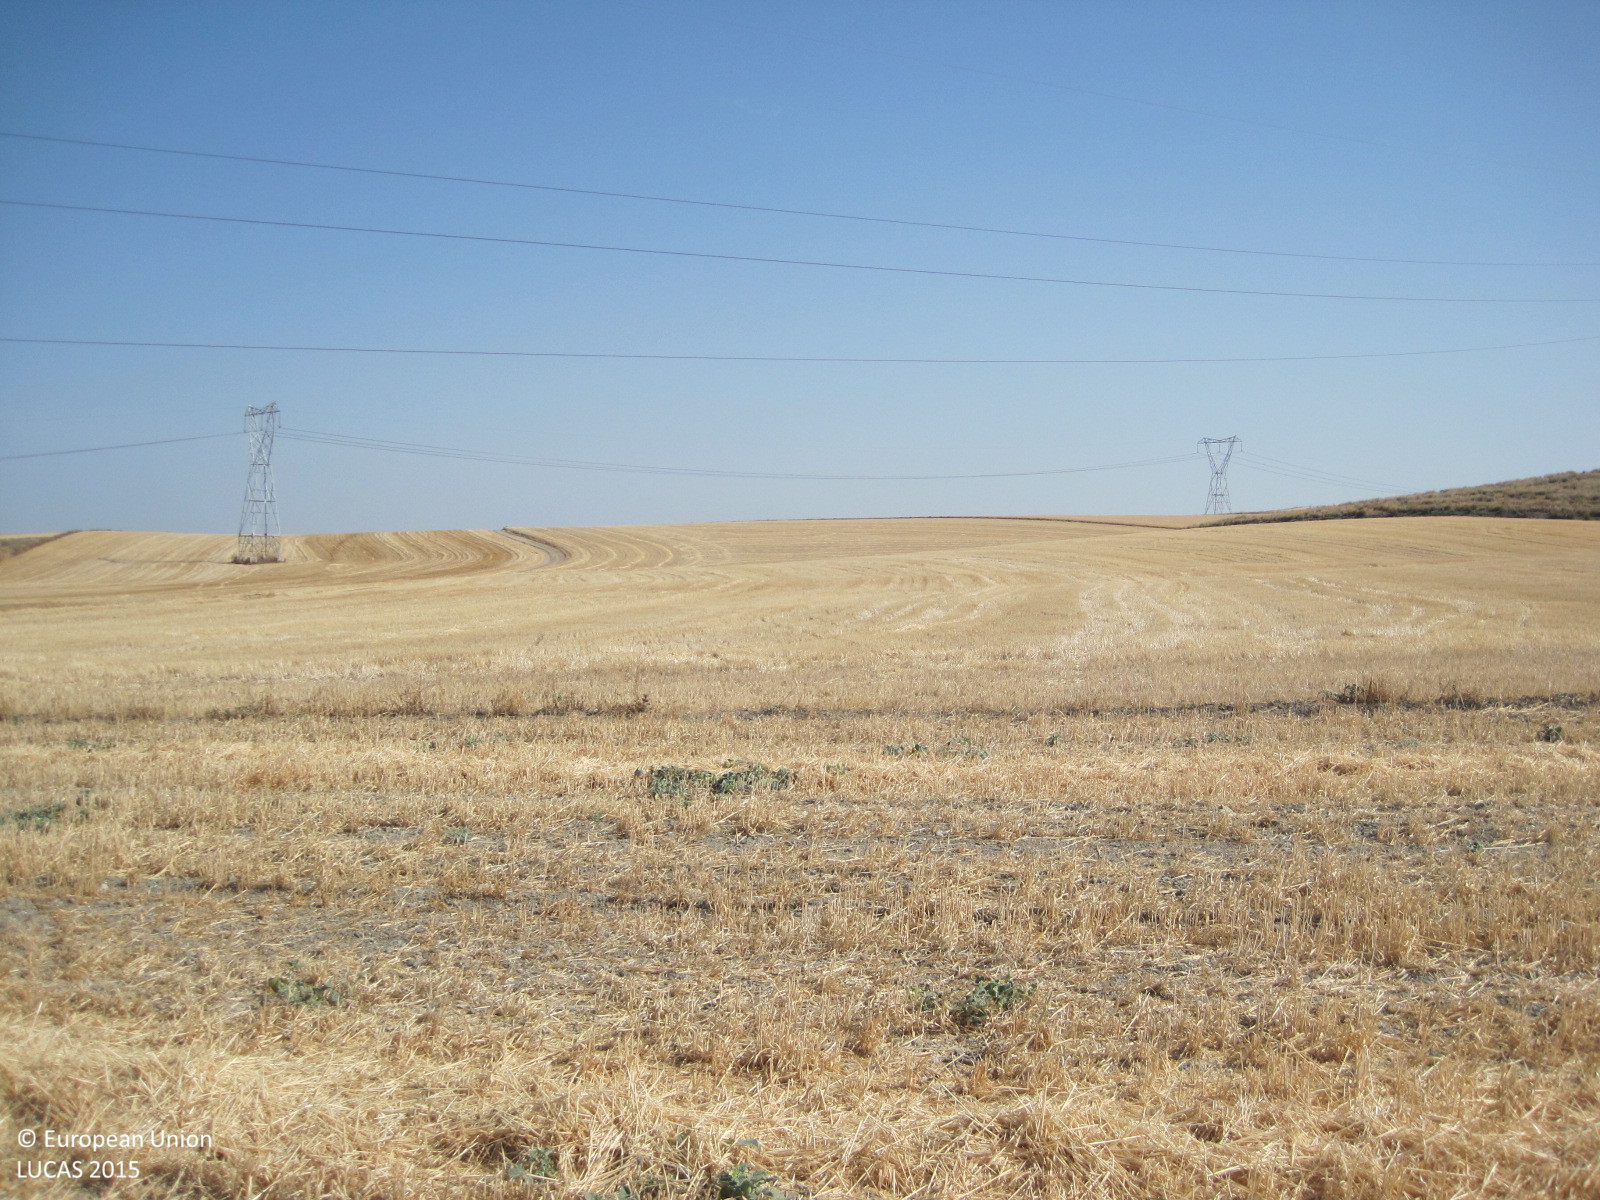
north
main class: Cropland
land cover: Barley
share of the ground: < 10 %
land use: Agriculture (excluding fallow land and kitchen gardens)
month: July
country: ES
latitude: 40.0376
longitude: -3.8045
